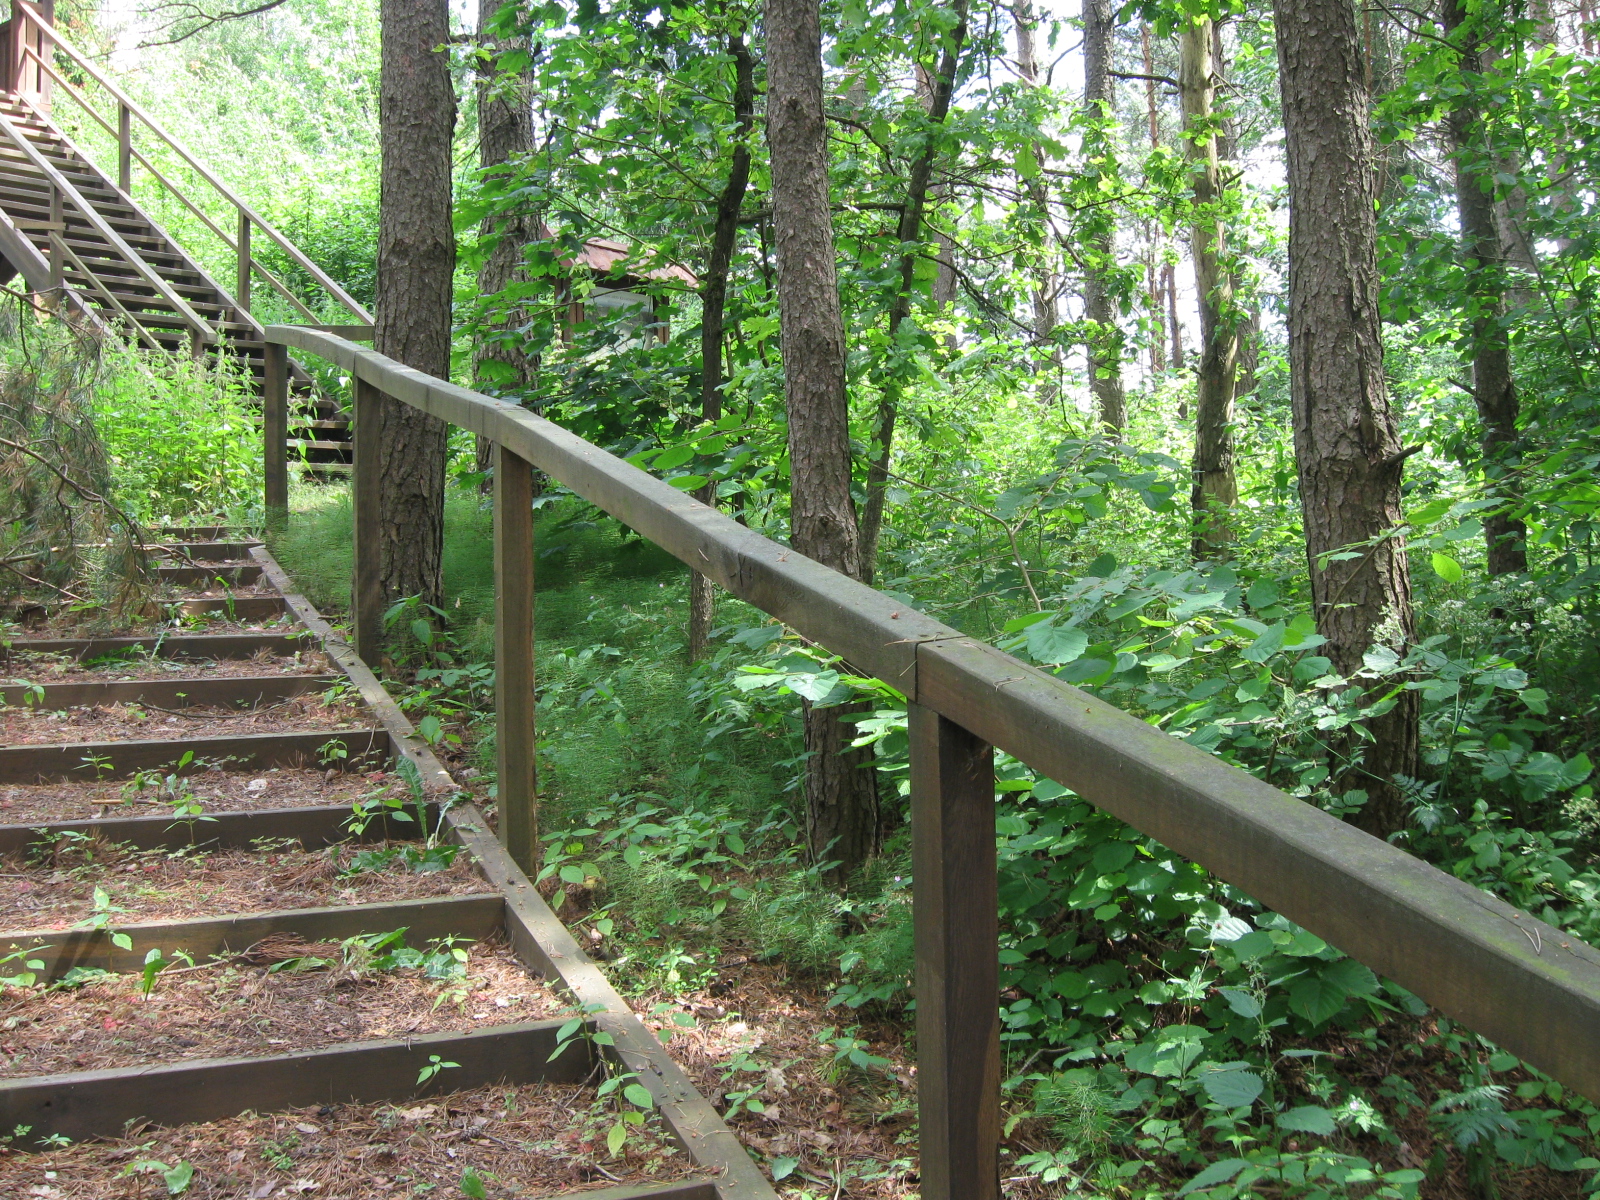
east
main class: Woodland
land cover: Pine dominated mixed woodland
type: hemiboreal forest and nemoral coniferous forest and mixed broadleaved-coniferous forest
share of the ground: > 75 %
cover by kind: coniferous forest trees 65 %, broadleaved forest trees 30 %, herbaceous plants 5 %
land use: Forestry
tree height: > 5 m
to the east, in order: Artificial constructions in urban areas; Pine dominated mixed woodland; Broadleaved woodland; Other mixed woodland; Broadleaved woodland; Shrubland without tree cover; Spontaneously vegetated surfaces; Broadleaved woodland; Shrubland with sparse tree cover; Broadleaved woodland; Shrubland without tree cover
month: June
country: LT
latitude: 54.6305
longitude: 24.4618
